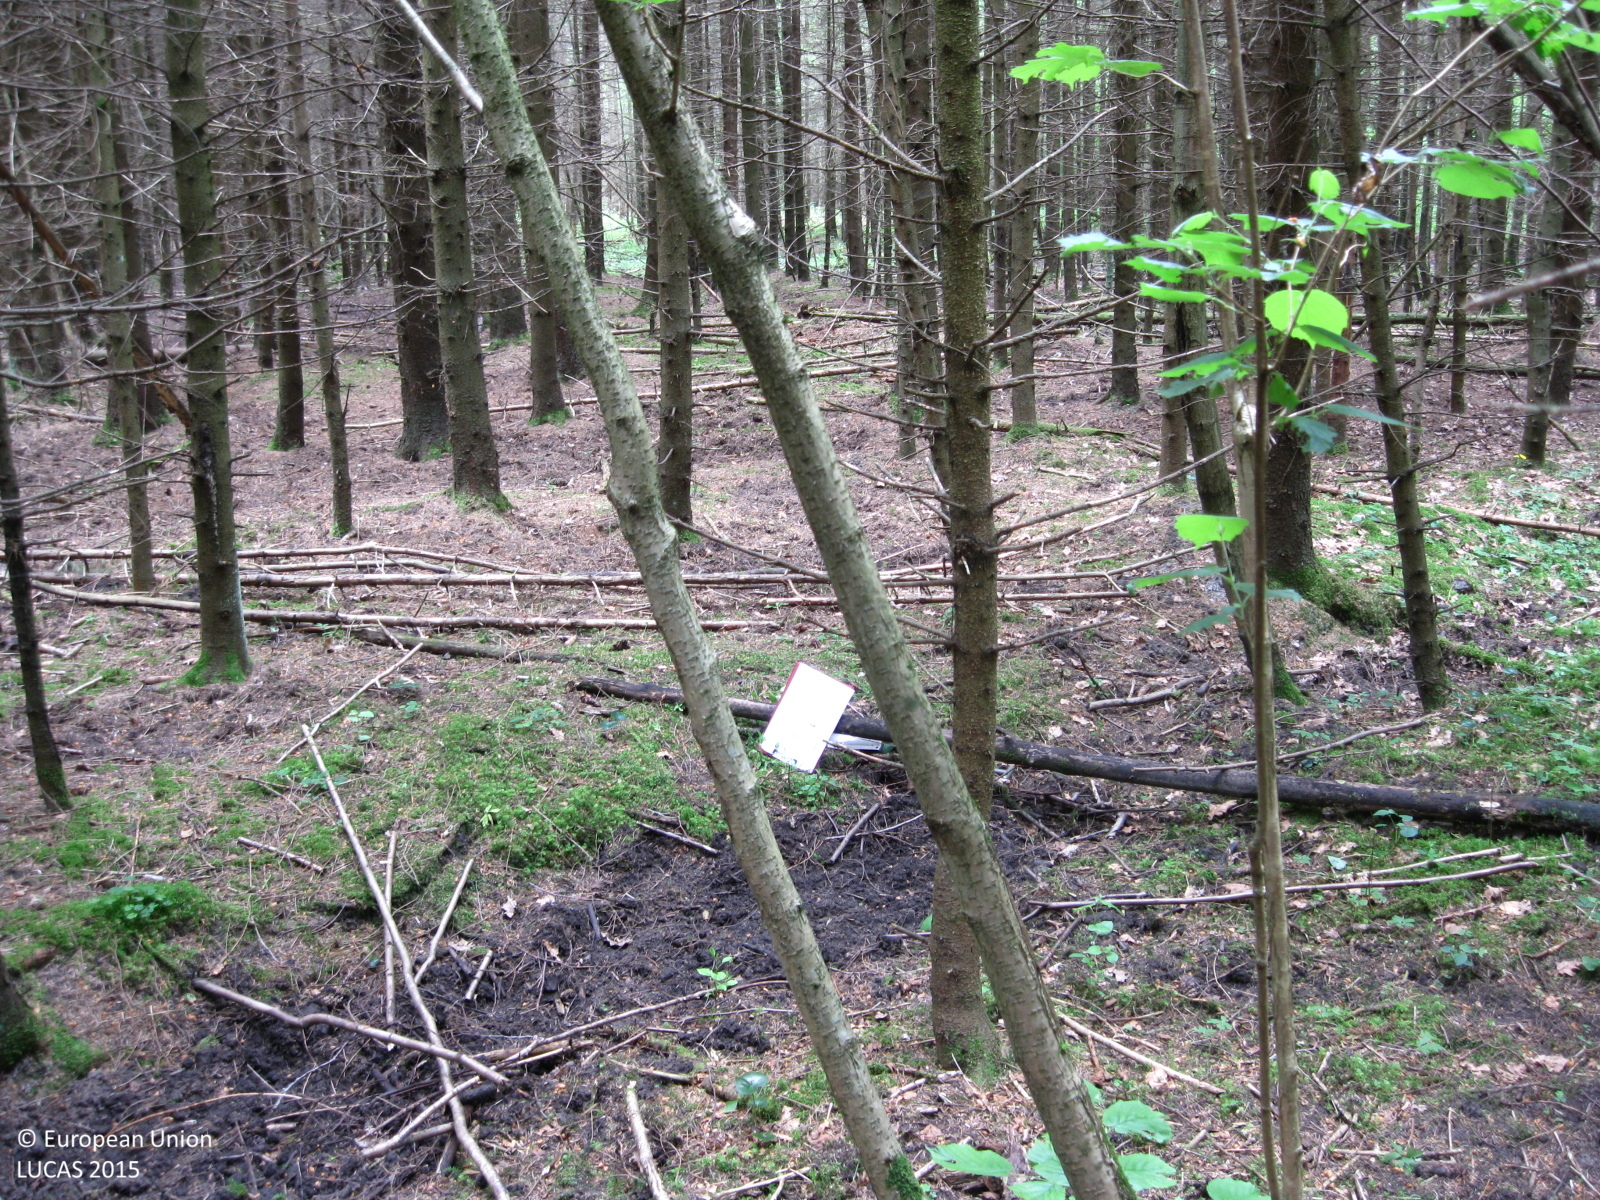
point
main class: Woodland
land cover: Spruce dominated coniferous woodland
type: hemiboreal forest and nemoral coniferous forest and mixed broadleaved-coniferous forest
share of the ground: > 75 %
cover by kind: coniferous forest trees 80 %, broadleaved forest trees 10 %, unconsolidated bare surface 10 %
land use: Forestry
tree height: > 5 m
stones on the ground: < 10 %
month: June
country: LT
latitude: 55.3828
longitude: 24.1240
